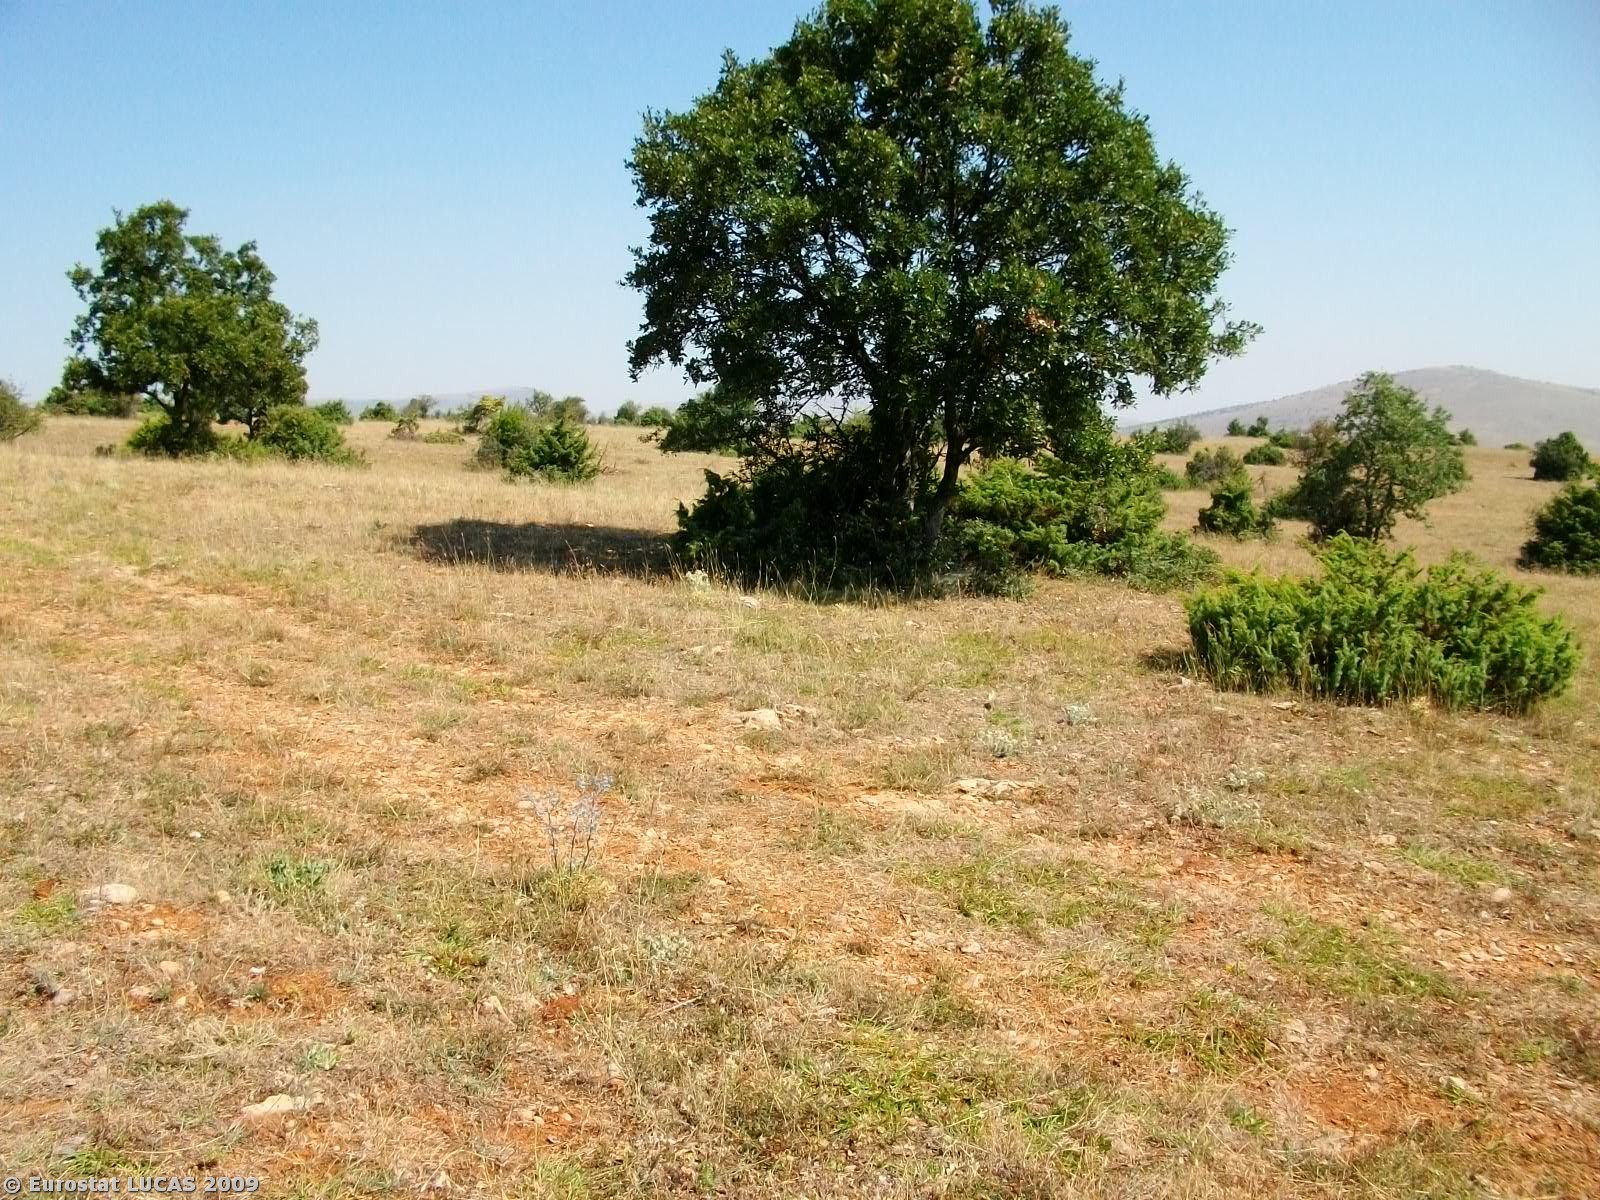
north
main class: Grassland
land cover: Grassland with sparse tree/shrub cover
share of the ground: > 75 %
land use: Agriculture (excluding fallow land and kitchen gardens)
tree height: > 5 m
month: July
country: GR
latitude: 40.2722
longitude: 21.7395
